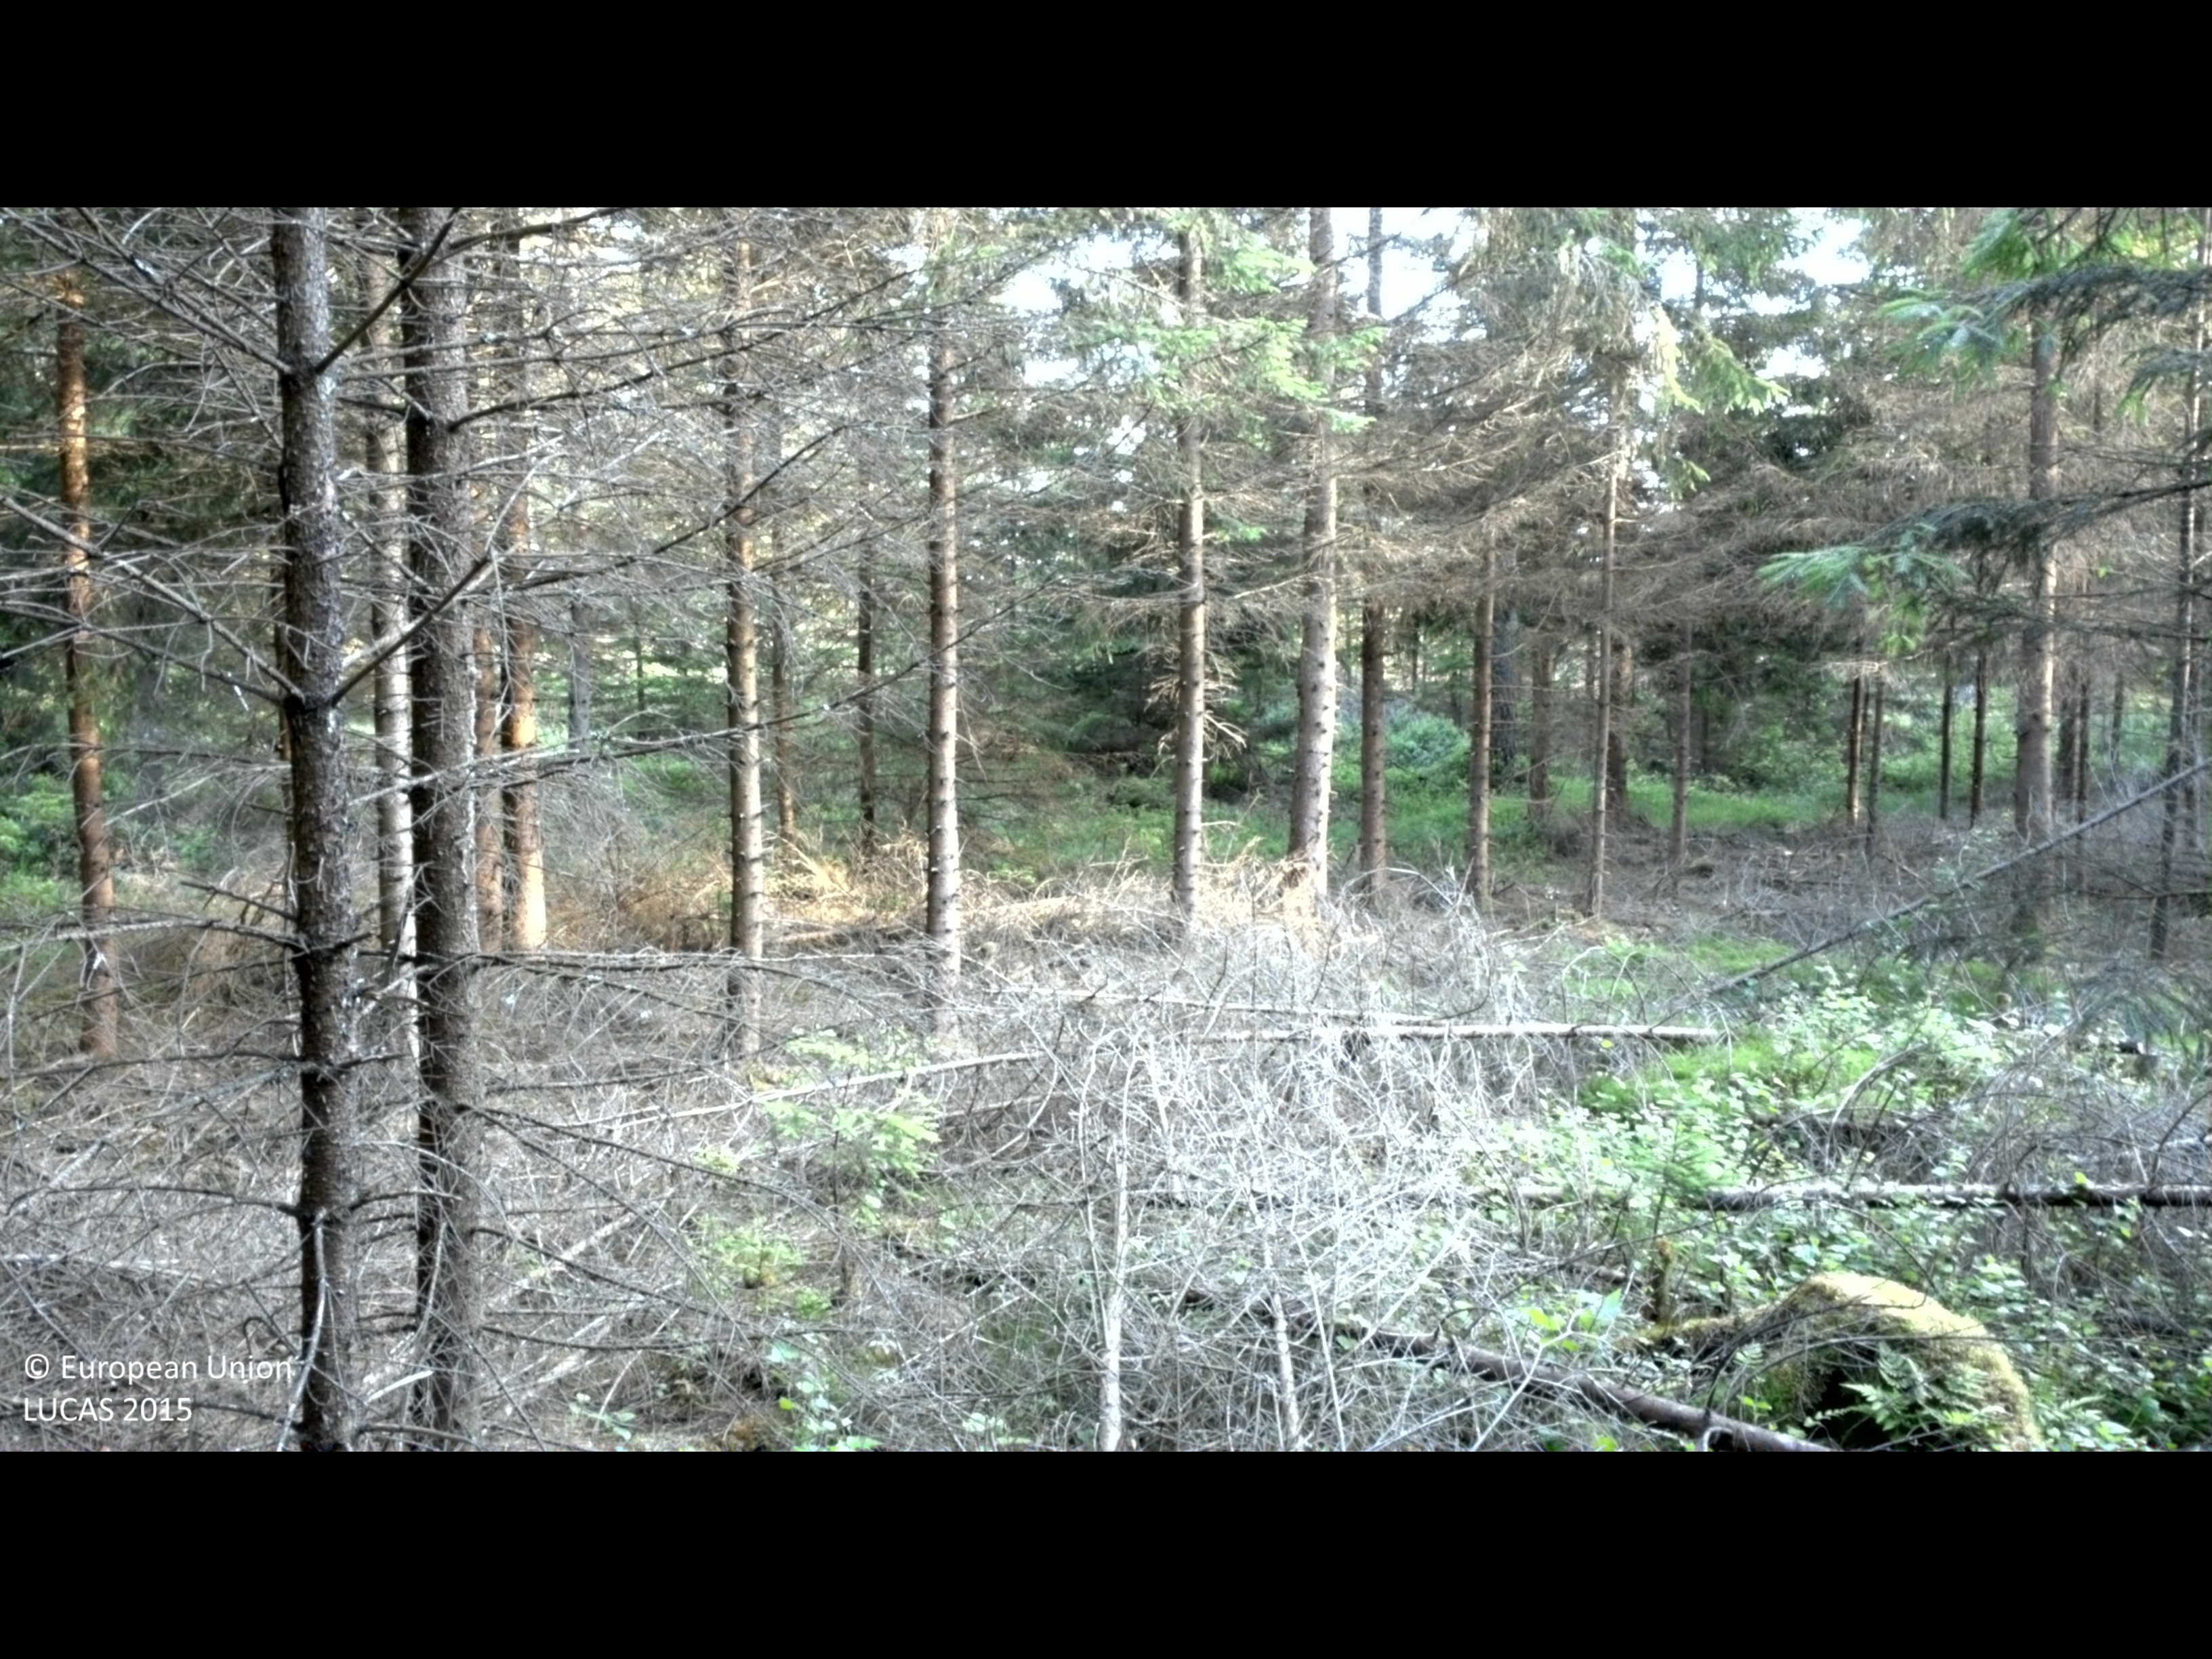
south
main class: Woodland
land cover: Spruce dominated coniferous woodland
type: boreal forest
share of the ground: > 75 %
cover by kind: coniferous forest trees 75 %, herbaceous plants 10 %, broadleaved forest trees 5 %, shrubs 5 %, lichens and mosses 5 %
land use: Forestry
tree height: > 5 m
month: July
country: SE
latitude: 56.4970
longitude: 14.2045
